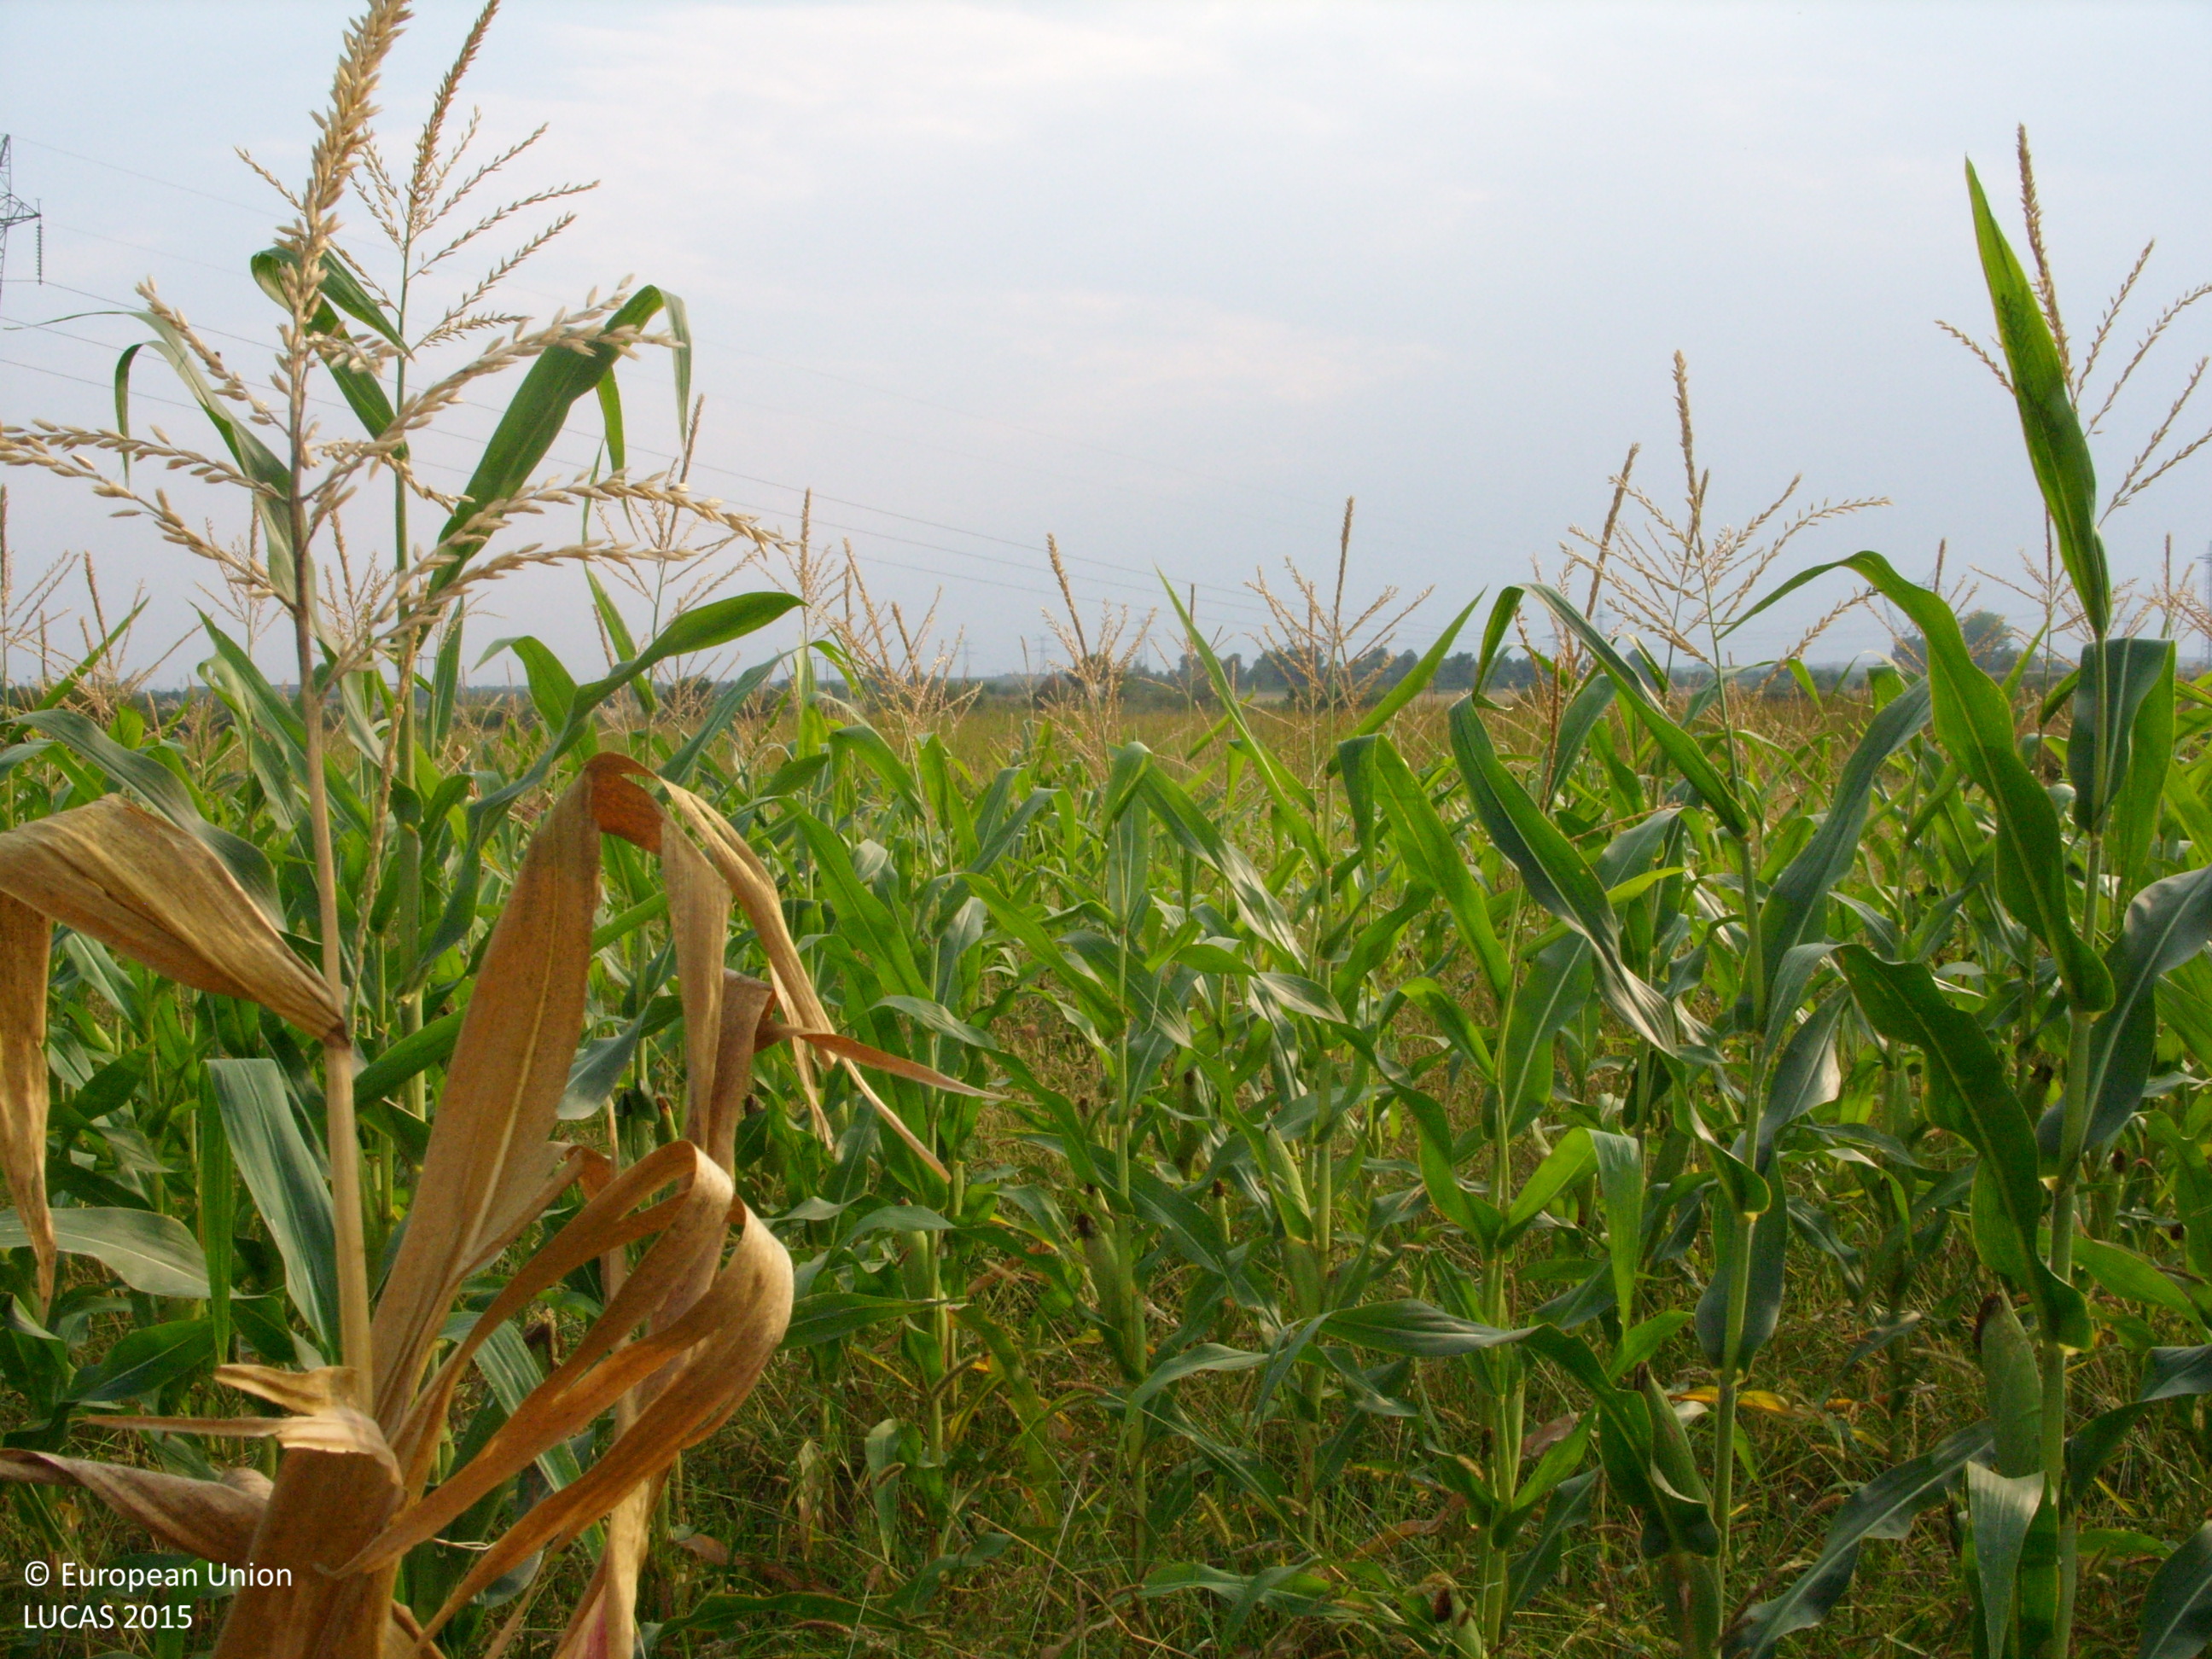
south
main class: Cropland
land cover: Maize
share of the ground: 50 - 75 %
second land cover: Spontaneously vegetated surfaces
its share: > 75 %
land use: Agriculture (excluding fallow land and kitchen gardens)
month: September
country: BG
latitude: 42.4252
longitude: 24.7737
